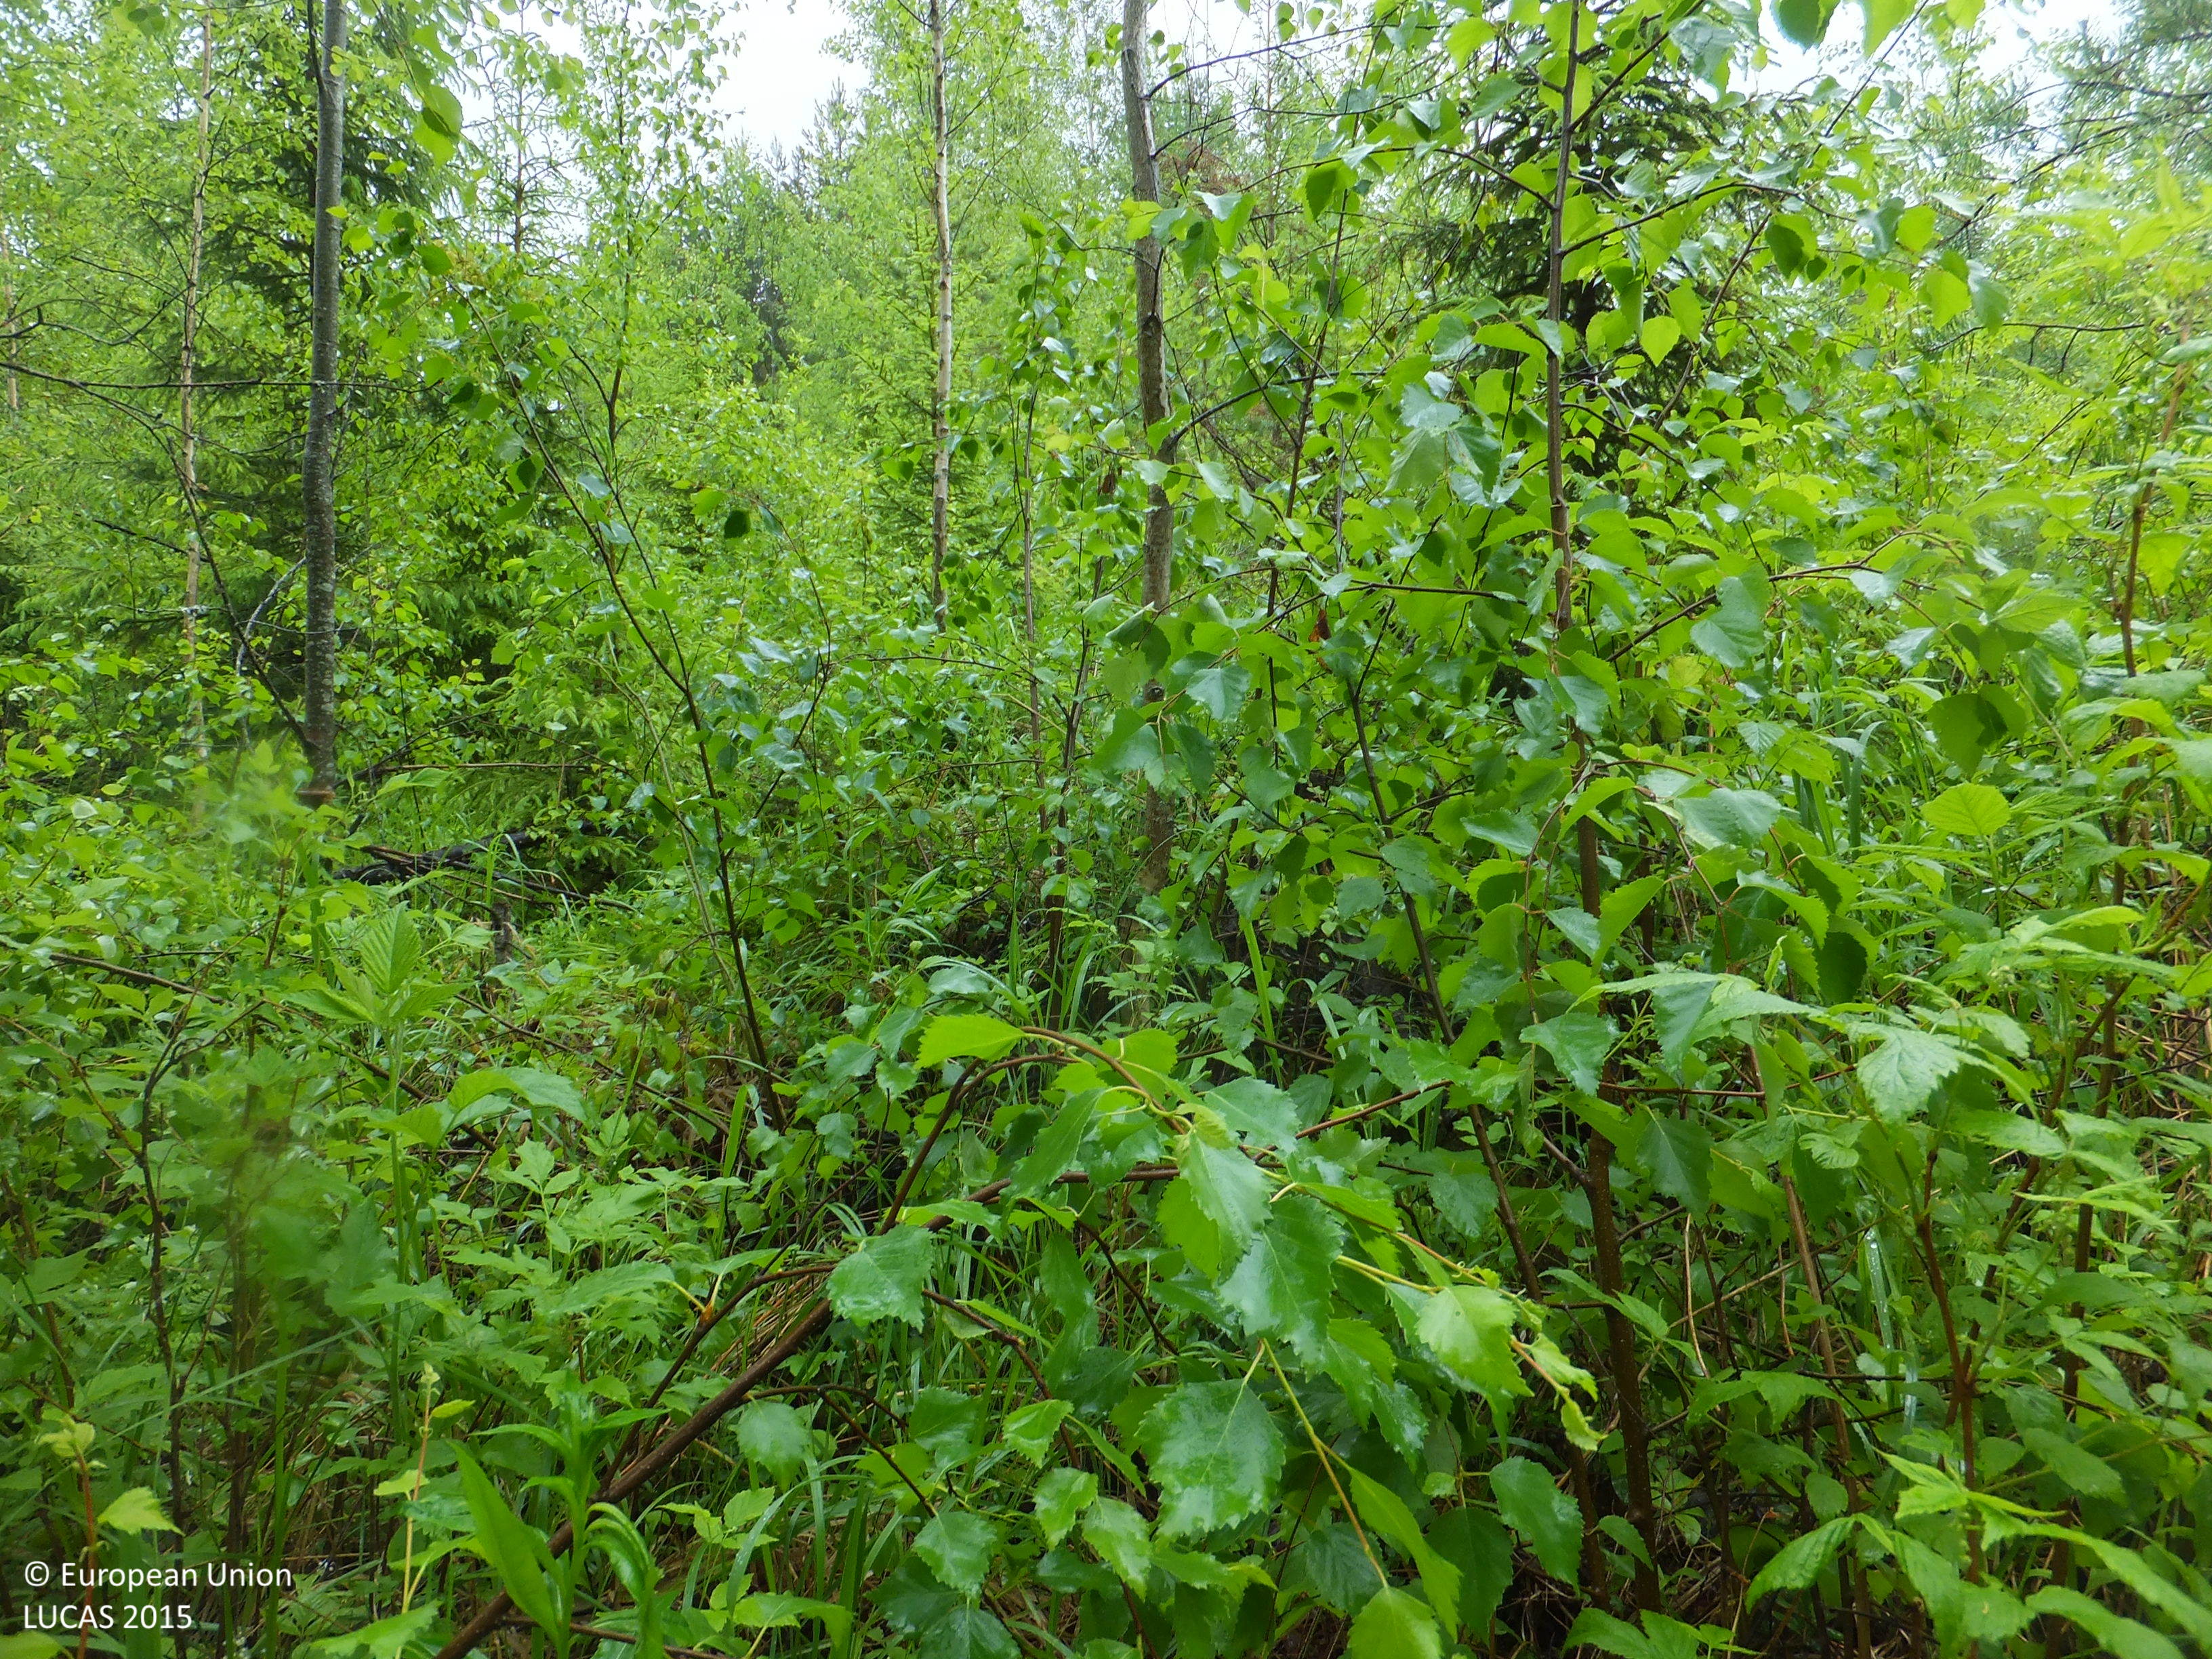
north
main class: Woodland
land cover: Spruce dominated mixed woodland
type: boreal forest
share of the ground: > 75 %
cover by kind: broadleaved forest trees 60 %, coniferous forest trees 25 %, herbaceous plants 10 %, shrubs 5 %
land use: Forestry
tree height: > 5 m
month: June
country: FI
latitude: 63.3571
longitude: 24.9008
